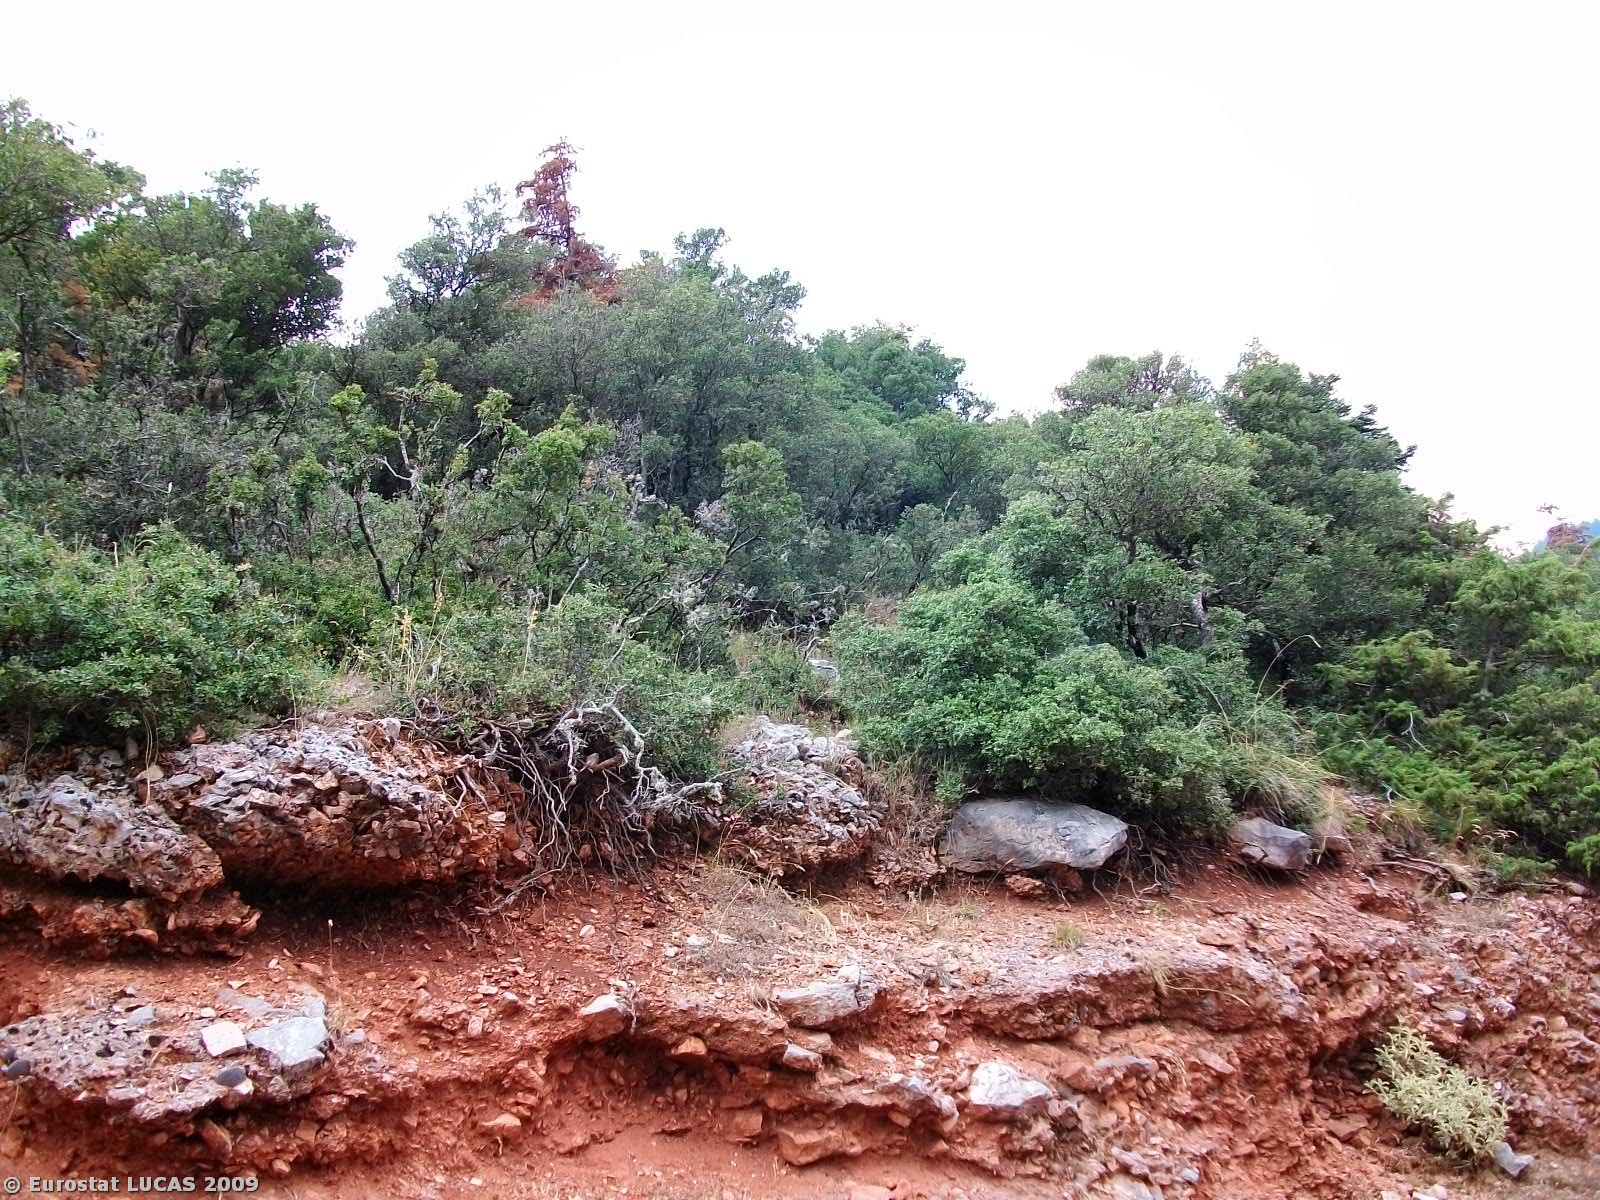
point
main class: Woodland
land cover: Broadleaved woodland
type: broadleaved evergreen forest
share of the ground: > 75 %
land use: Forestry
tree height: > 5 m
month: August
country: GR
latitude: 38.7235
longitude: 21.5546
